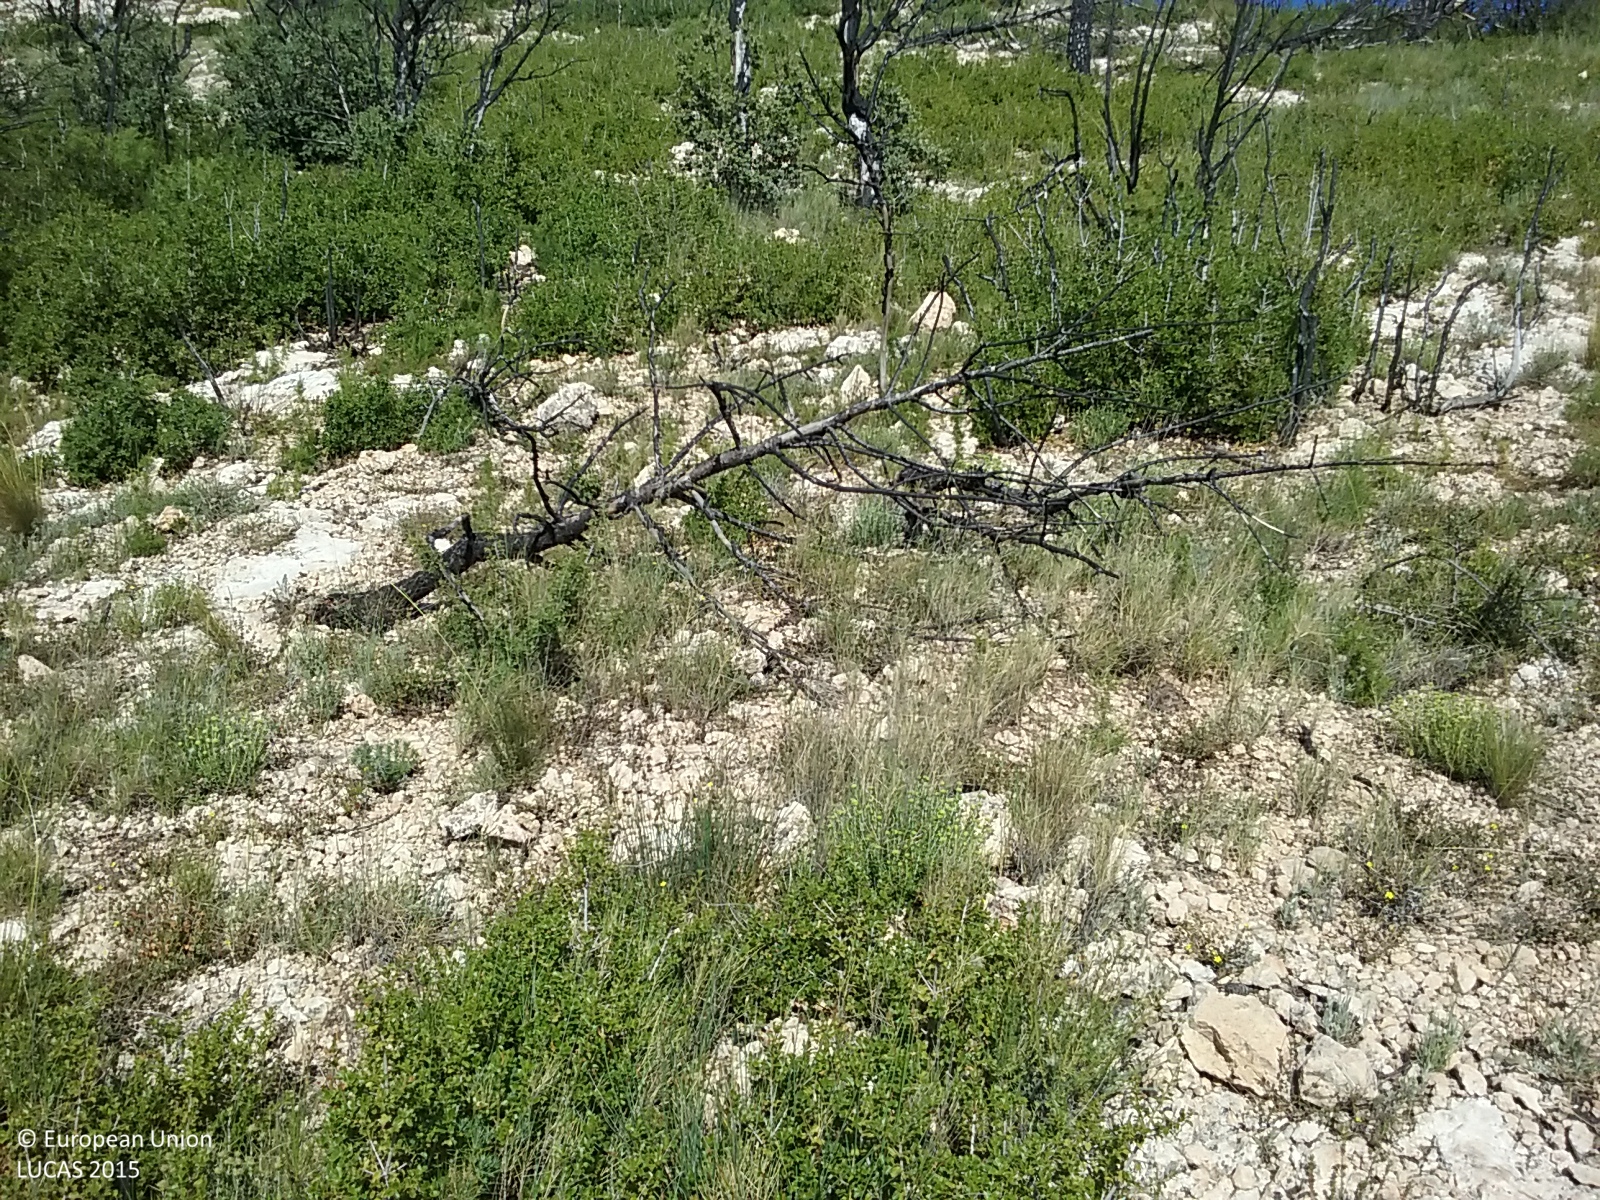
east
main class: Shrubland
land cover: Shrubland without tree cover
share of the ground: 25 - 50 %
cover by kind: unconsolidated bare surface 50 %, shrubs 30 %, herbaceous plants 20 %
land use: Semi-natural and natural areas not in use
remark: Burnt area
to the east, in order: Shrubland without tree cover
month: June
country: ES
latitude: 39.8321
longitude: -0.6472
